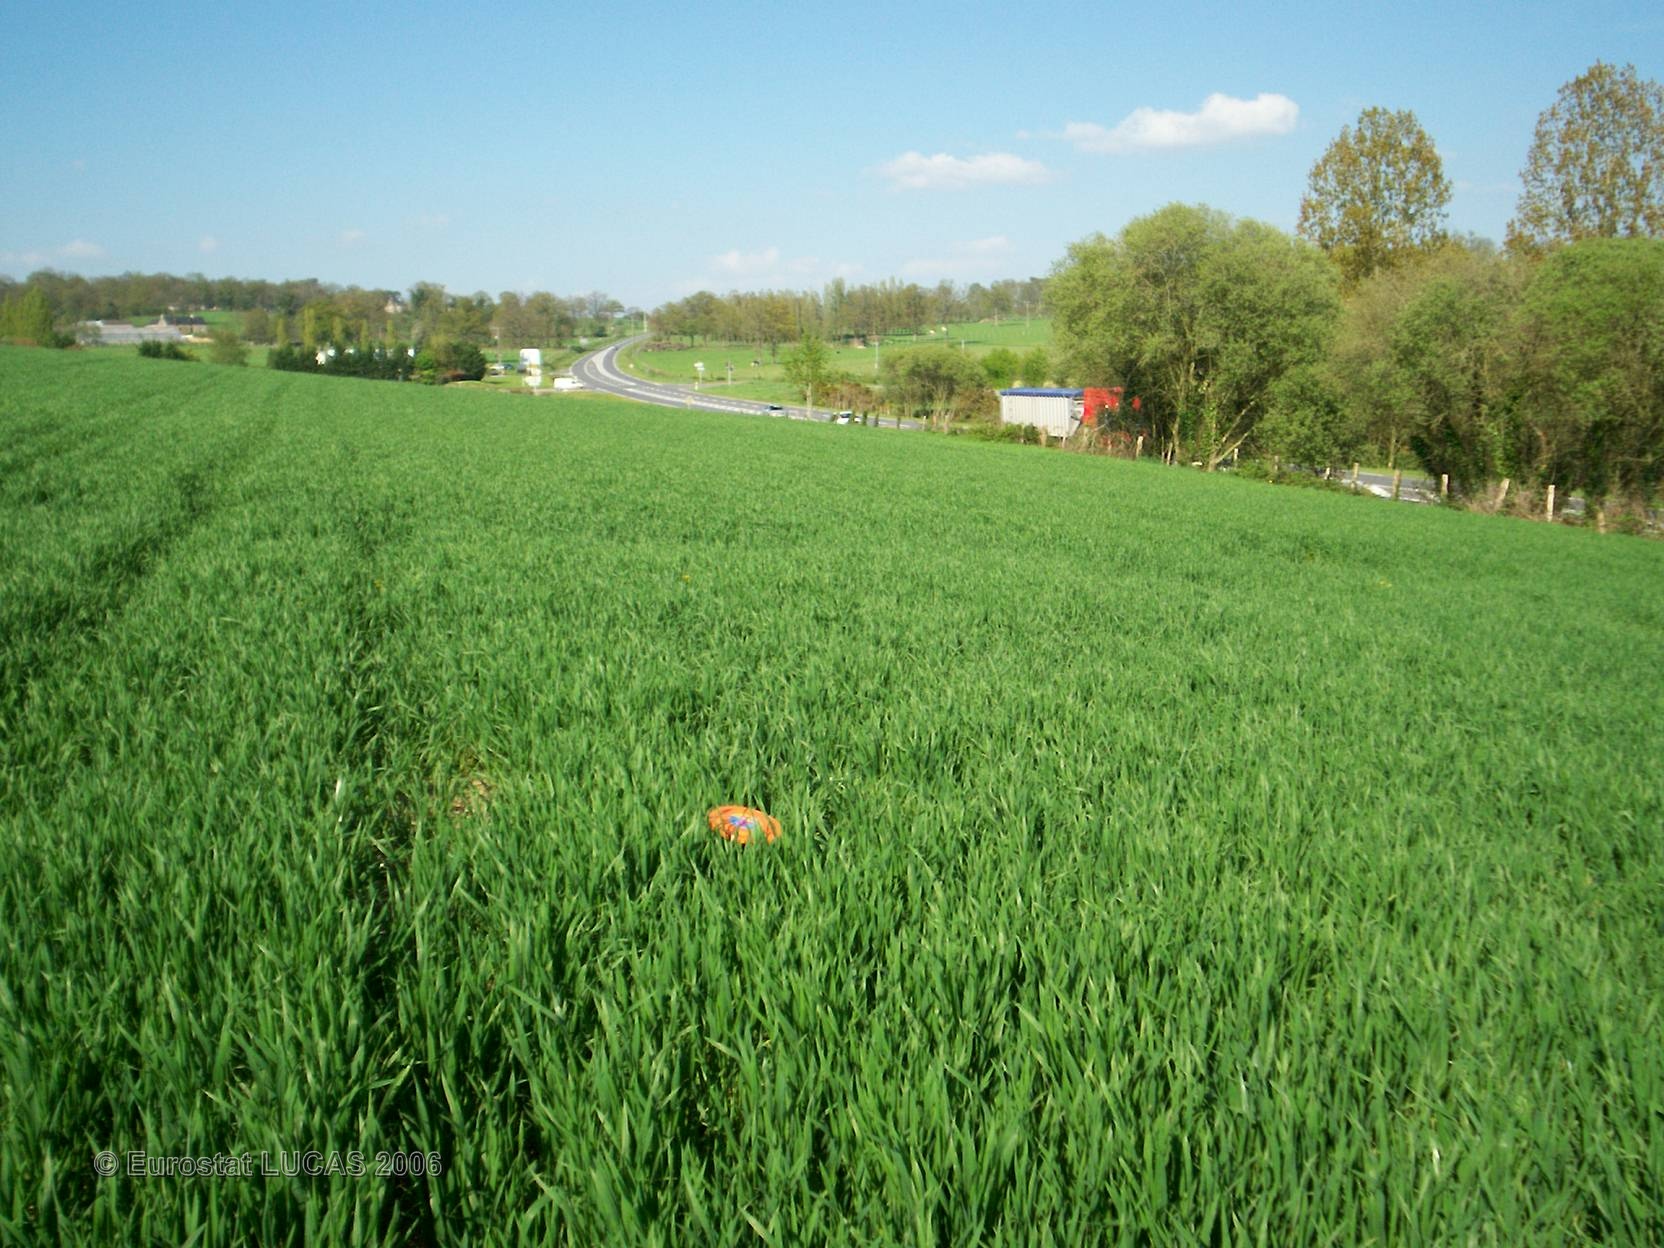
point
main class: Cropland
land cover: Common wheat
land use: Agriculture (excluding fallow land and kitchen gardens)
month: May
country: FR
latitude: 48.2168
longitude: -1.1723
